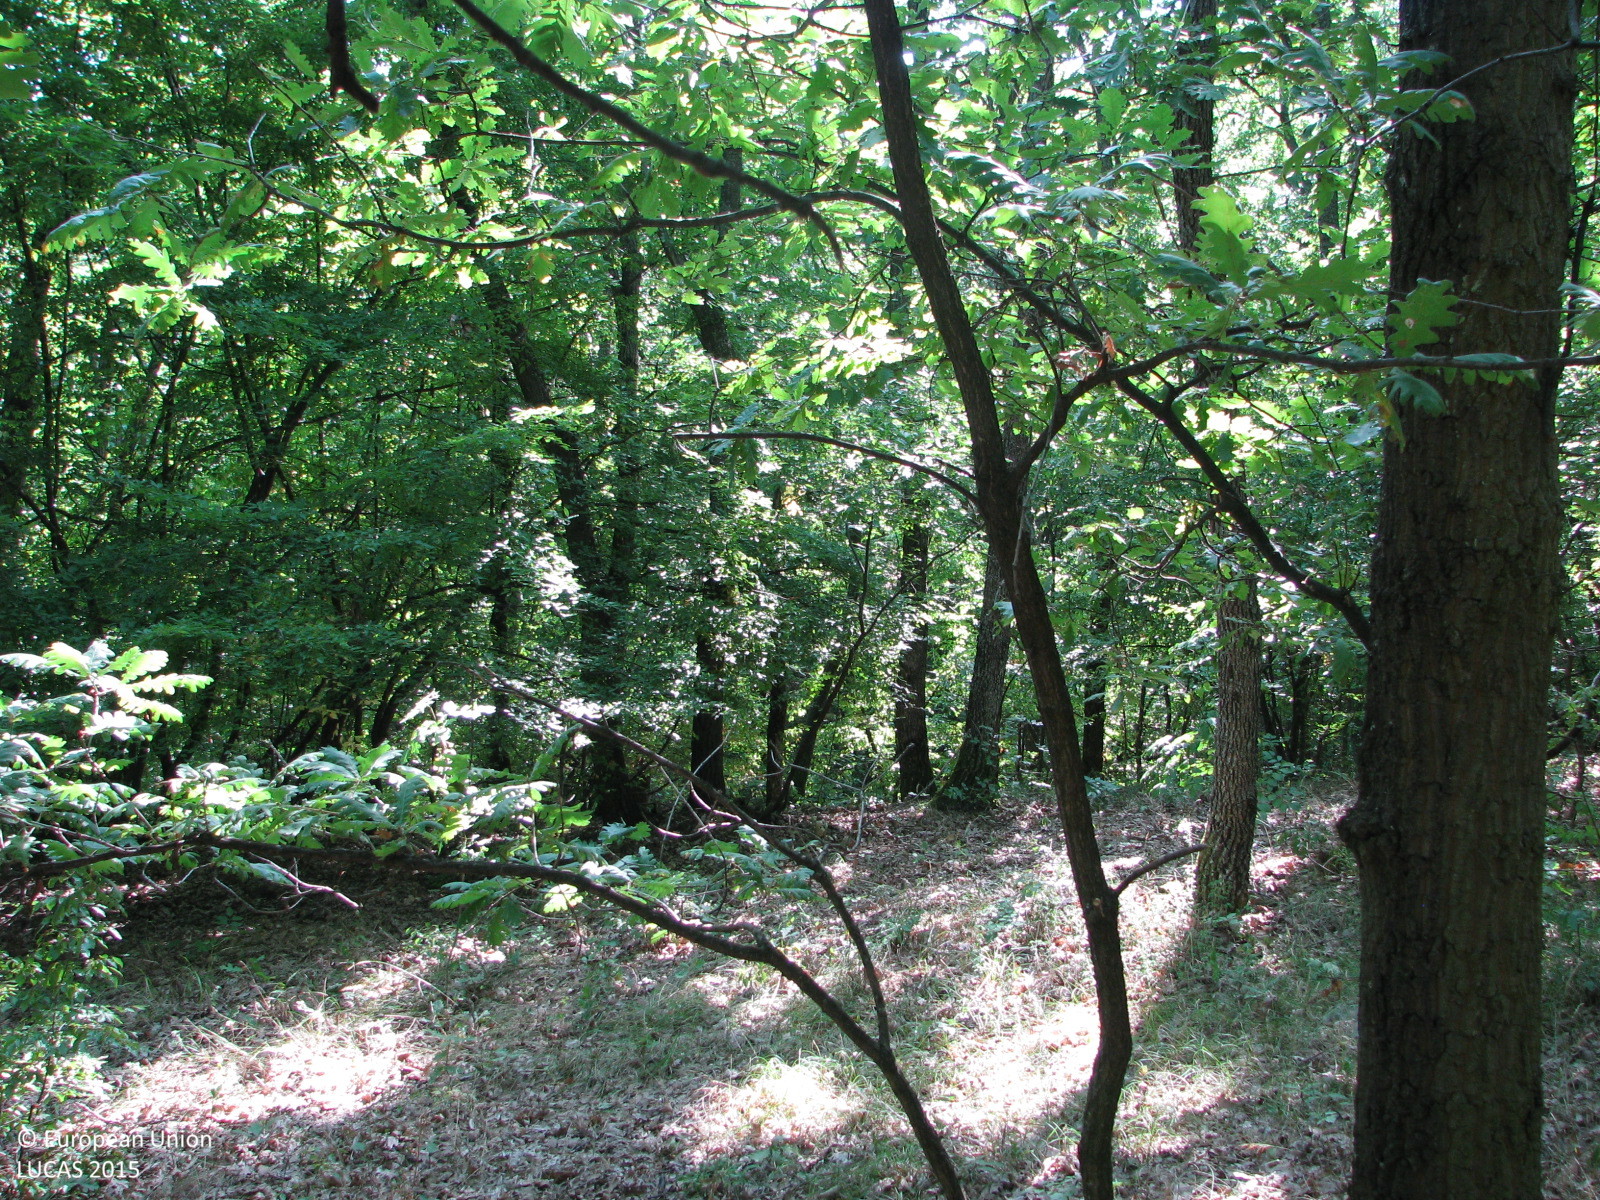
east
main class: Woodland
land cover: Broadleaved woodland
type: acidophilous oak and oak-birch forest
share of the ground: 50 - 75 %
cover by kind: broadleaved forest trees 55 %, consolidated bare surface 30 %, shrubs 5 %, herbaceous plants 5 %, lichens and mosses 5 %
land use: Forestry
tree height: > 5 m
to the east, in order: Broadleaved woodland; Ditches and canals; Broadleaved woodland; Tracks; Broadleaved woodland; Ditches and canals; Broadleaved woodland; Ditches and canals; Broadleaved woodland
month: August
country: BG
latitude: 42.6933
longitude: 26.6876
